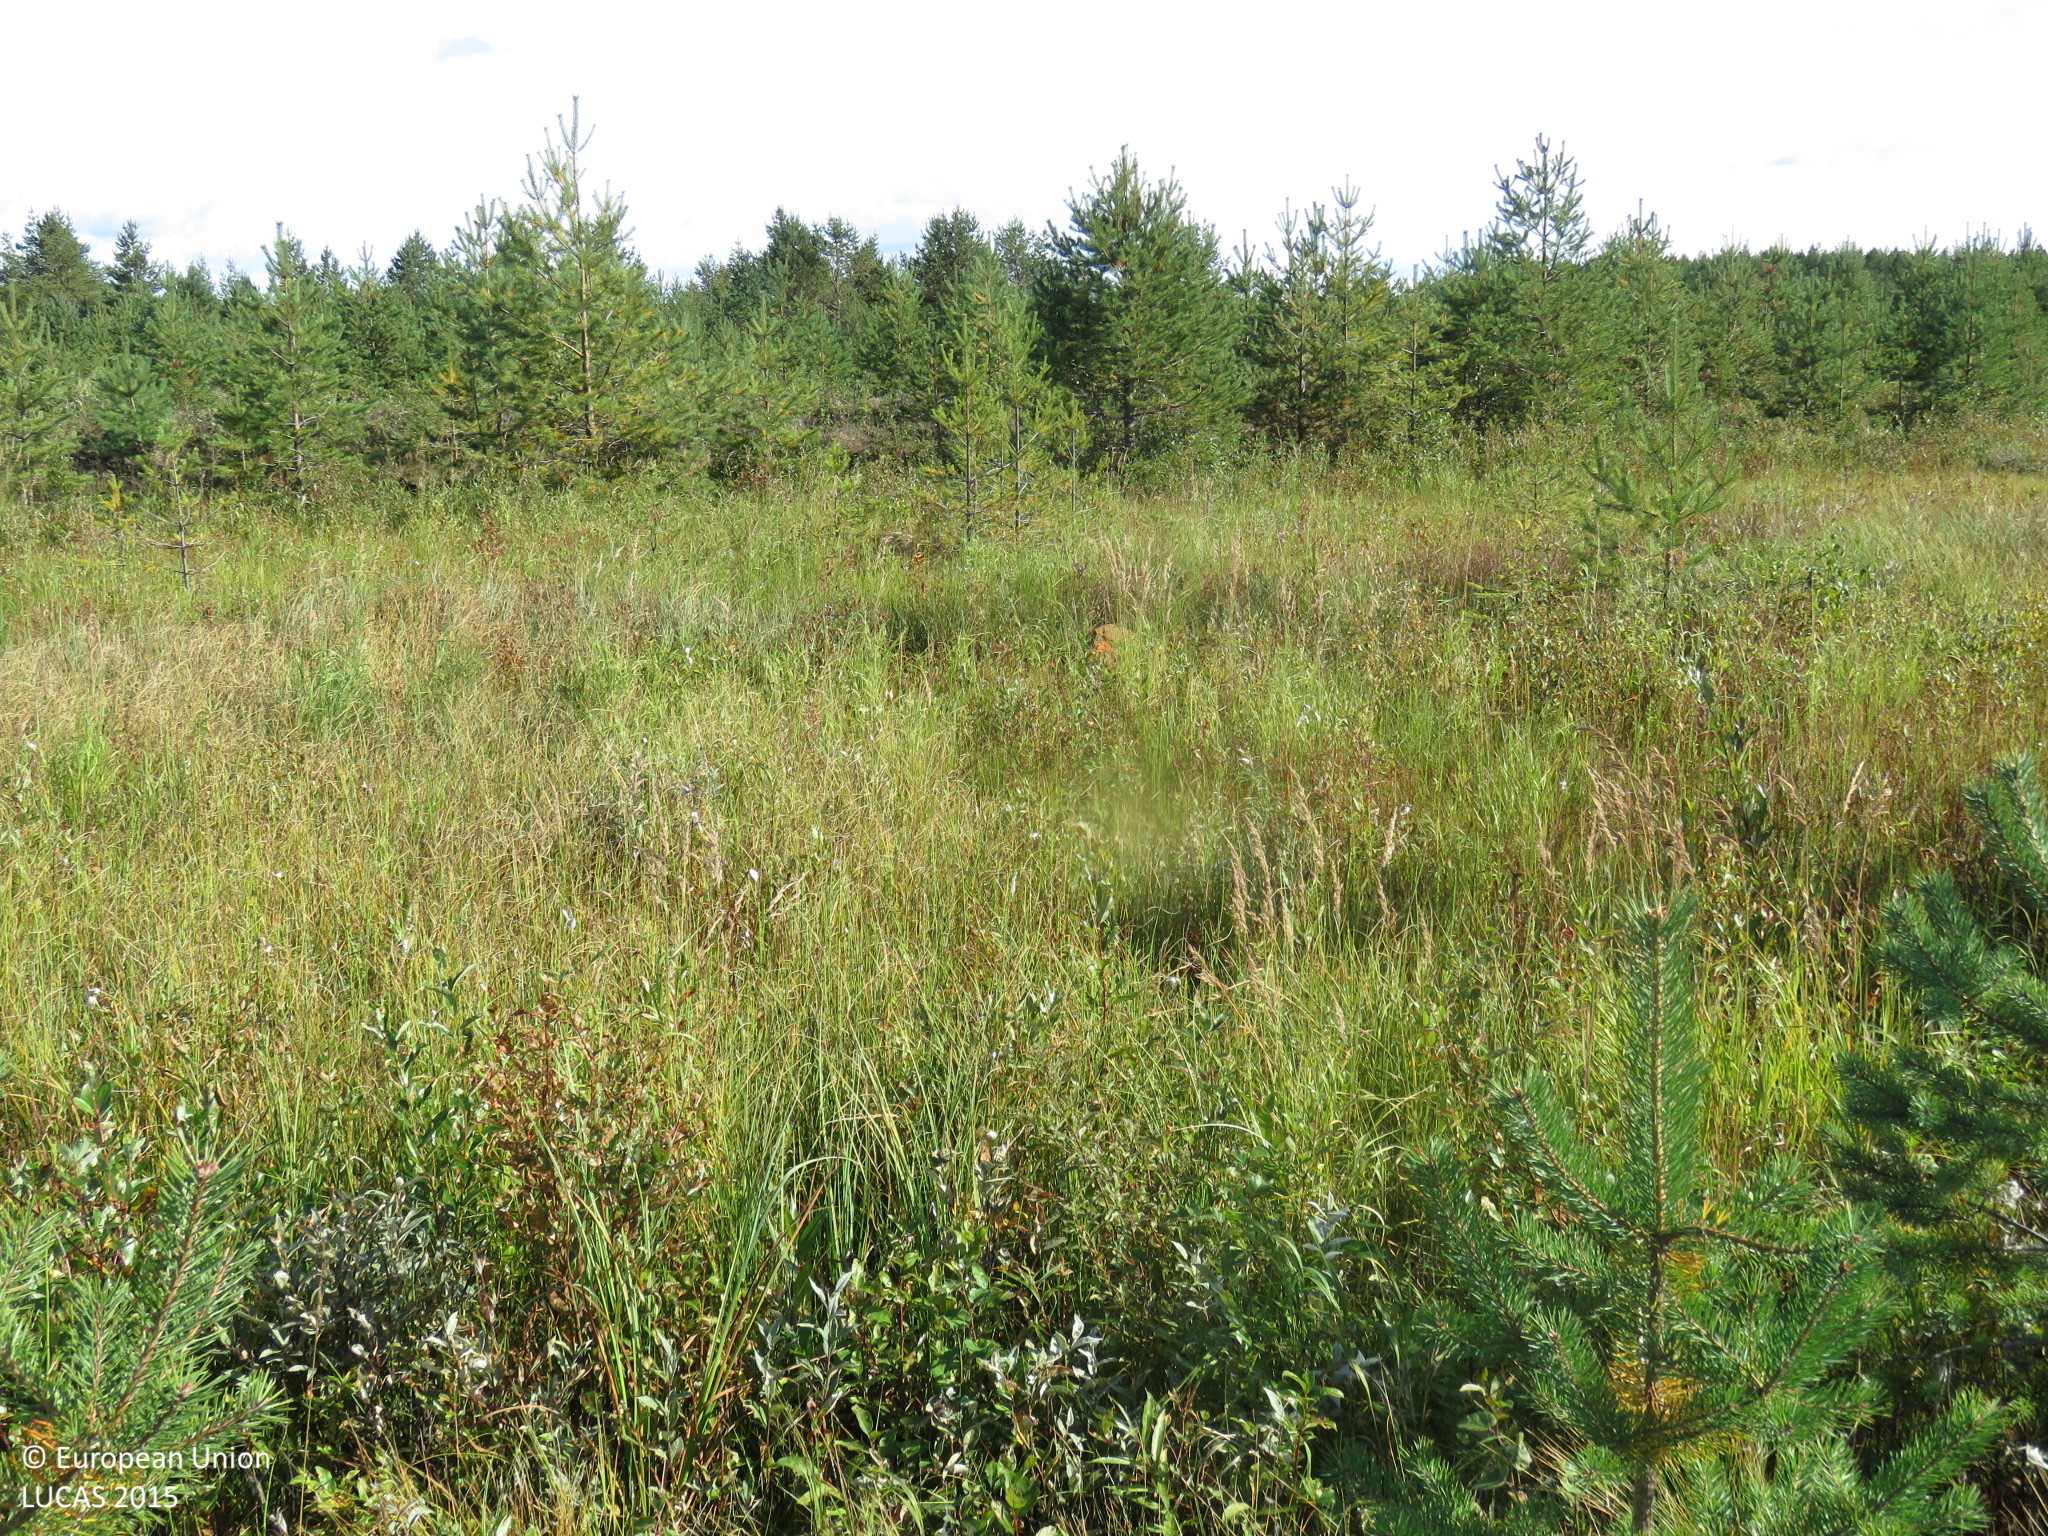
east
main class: Woodland
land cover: Pine dominated mixed woodland
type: mire and swamp forests
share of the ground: 10 - 25 %
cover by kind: unconsolidated bare surface 50 %, herbaceous plants 30 %, coniferous forest trees 10 %, broadleaved forest trees 5 %, lichens and mosses 5 %
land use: Abandoned areas
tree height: < 5 m
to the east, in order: Pine dominated mixed woodland; Spontaneously vegetated surfaces; Inland marshes; Ditches and canals; Inland marshes; Shrubland with sparse tree cover; Pine dominated coniferous woodland; Inland marshes; Grassland with sparse tree/shrub cover; Spontaneously vegetated surfaces; Ditches and canals; Pine dominated coniferous woodland; Inland marshes; Ditches and canals; Pine dominated coniferous woodland; Inland marshes; Ditches and canals; Inland marshes; Pine dominated coniferous woodland; Ditches and canals; Pine dominated coniferous woodland; Peatbogs; Pine dominated mixed woodland; Peatbogs
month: August
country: FI
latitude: 65.2770
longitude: 26.0576
